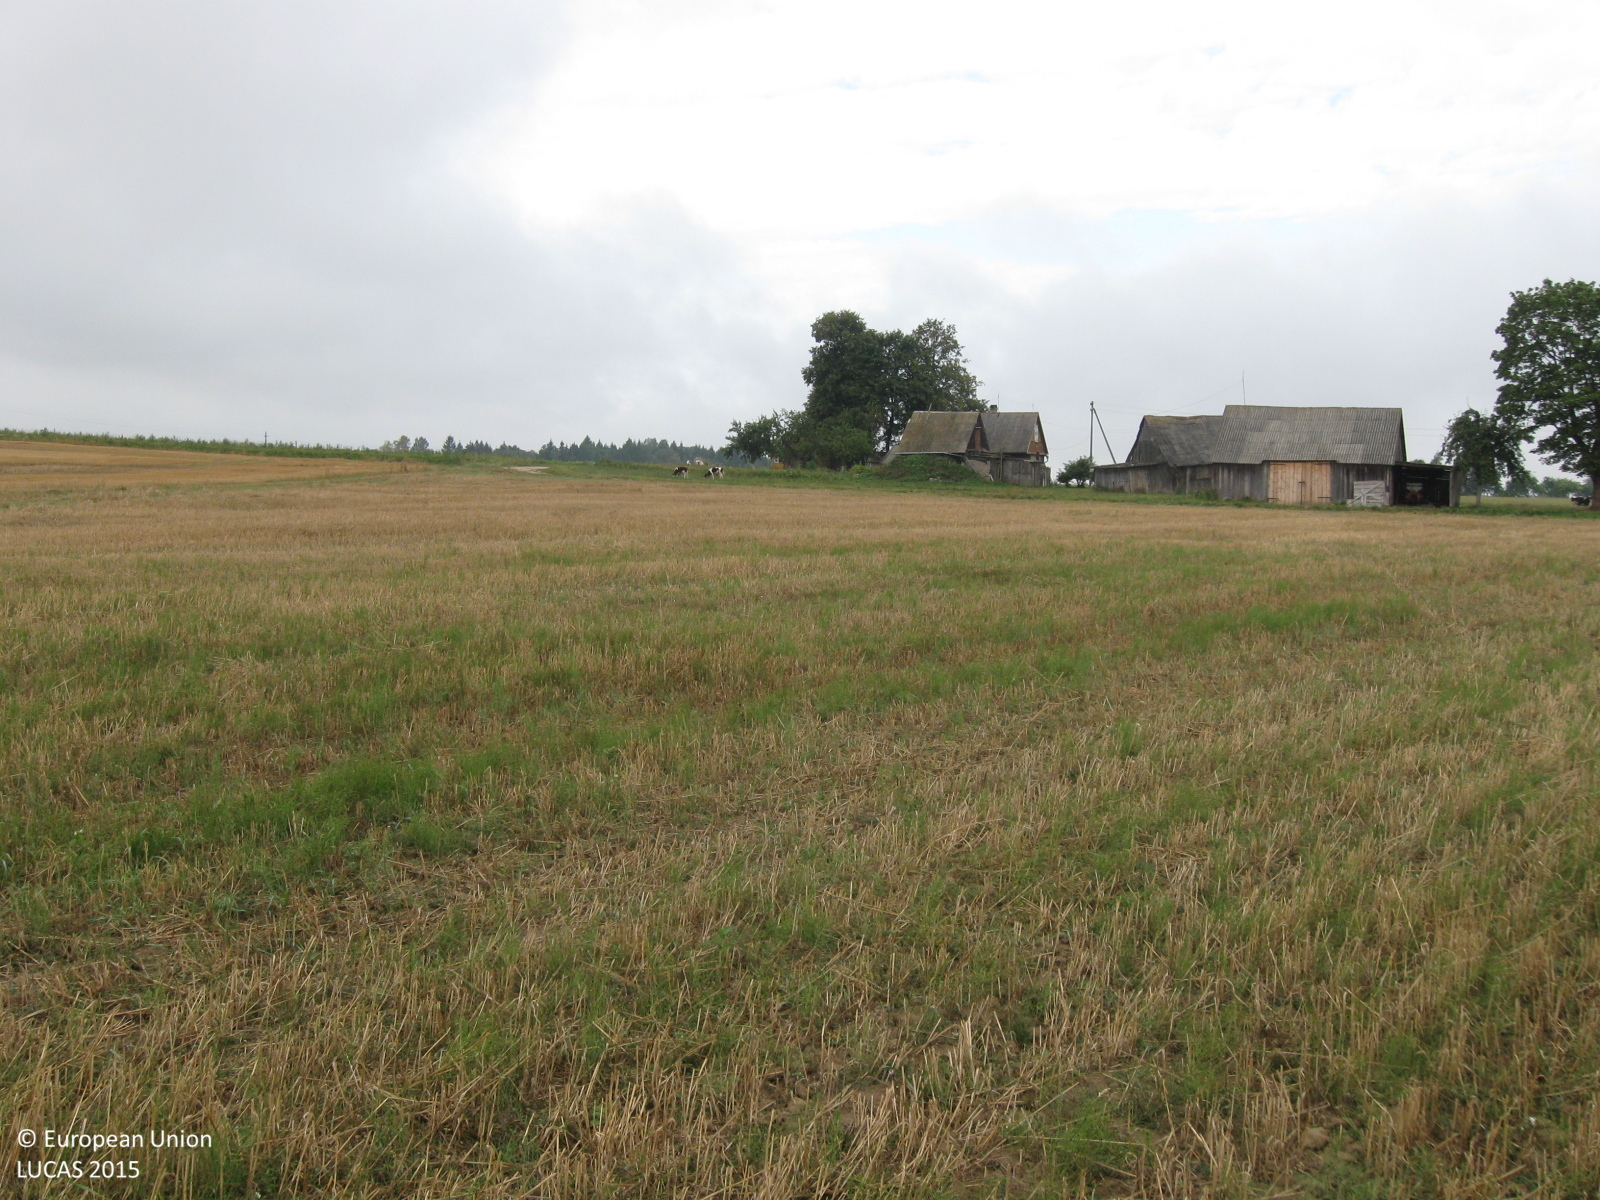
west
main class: Cropland
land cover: Common wheat
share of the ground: > 75 %
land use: Agriculture (excluding fallow land and kitchen gardens)
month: August
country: LT
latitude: 55.3656
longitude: 23.2806
